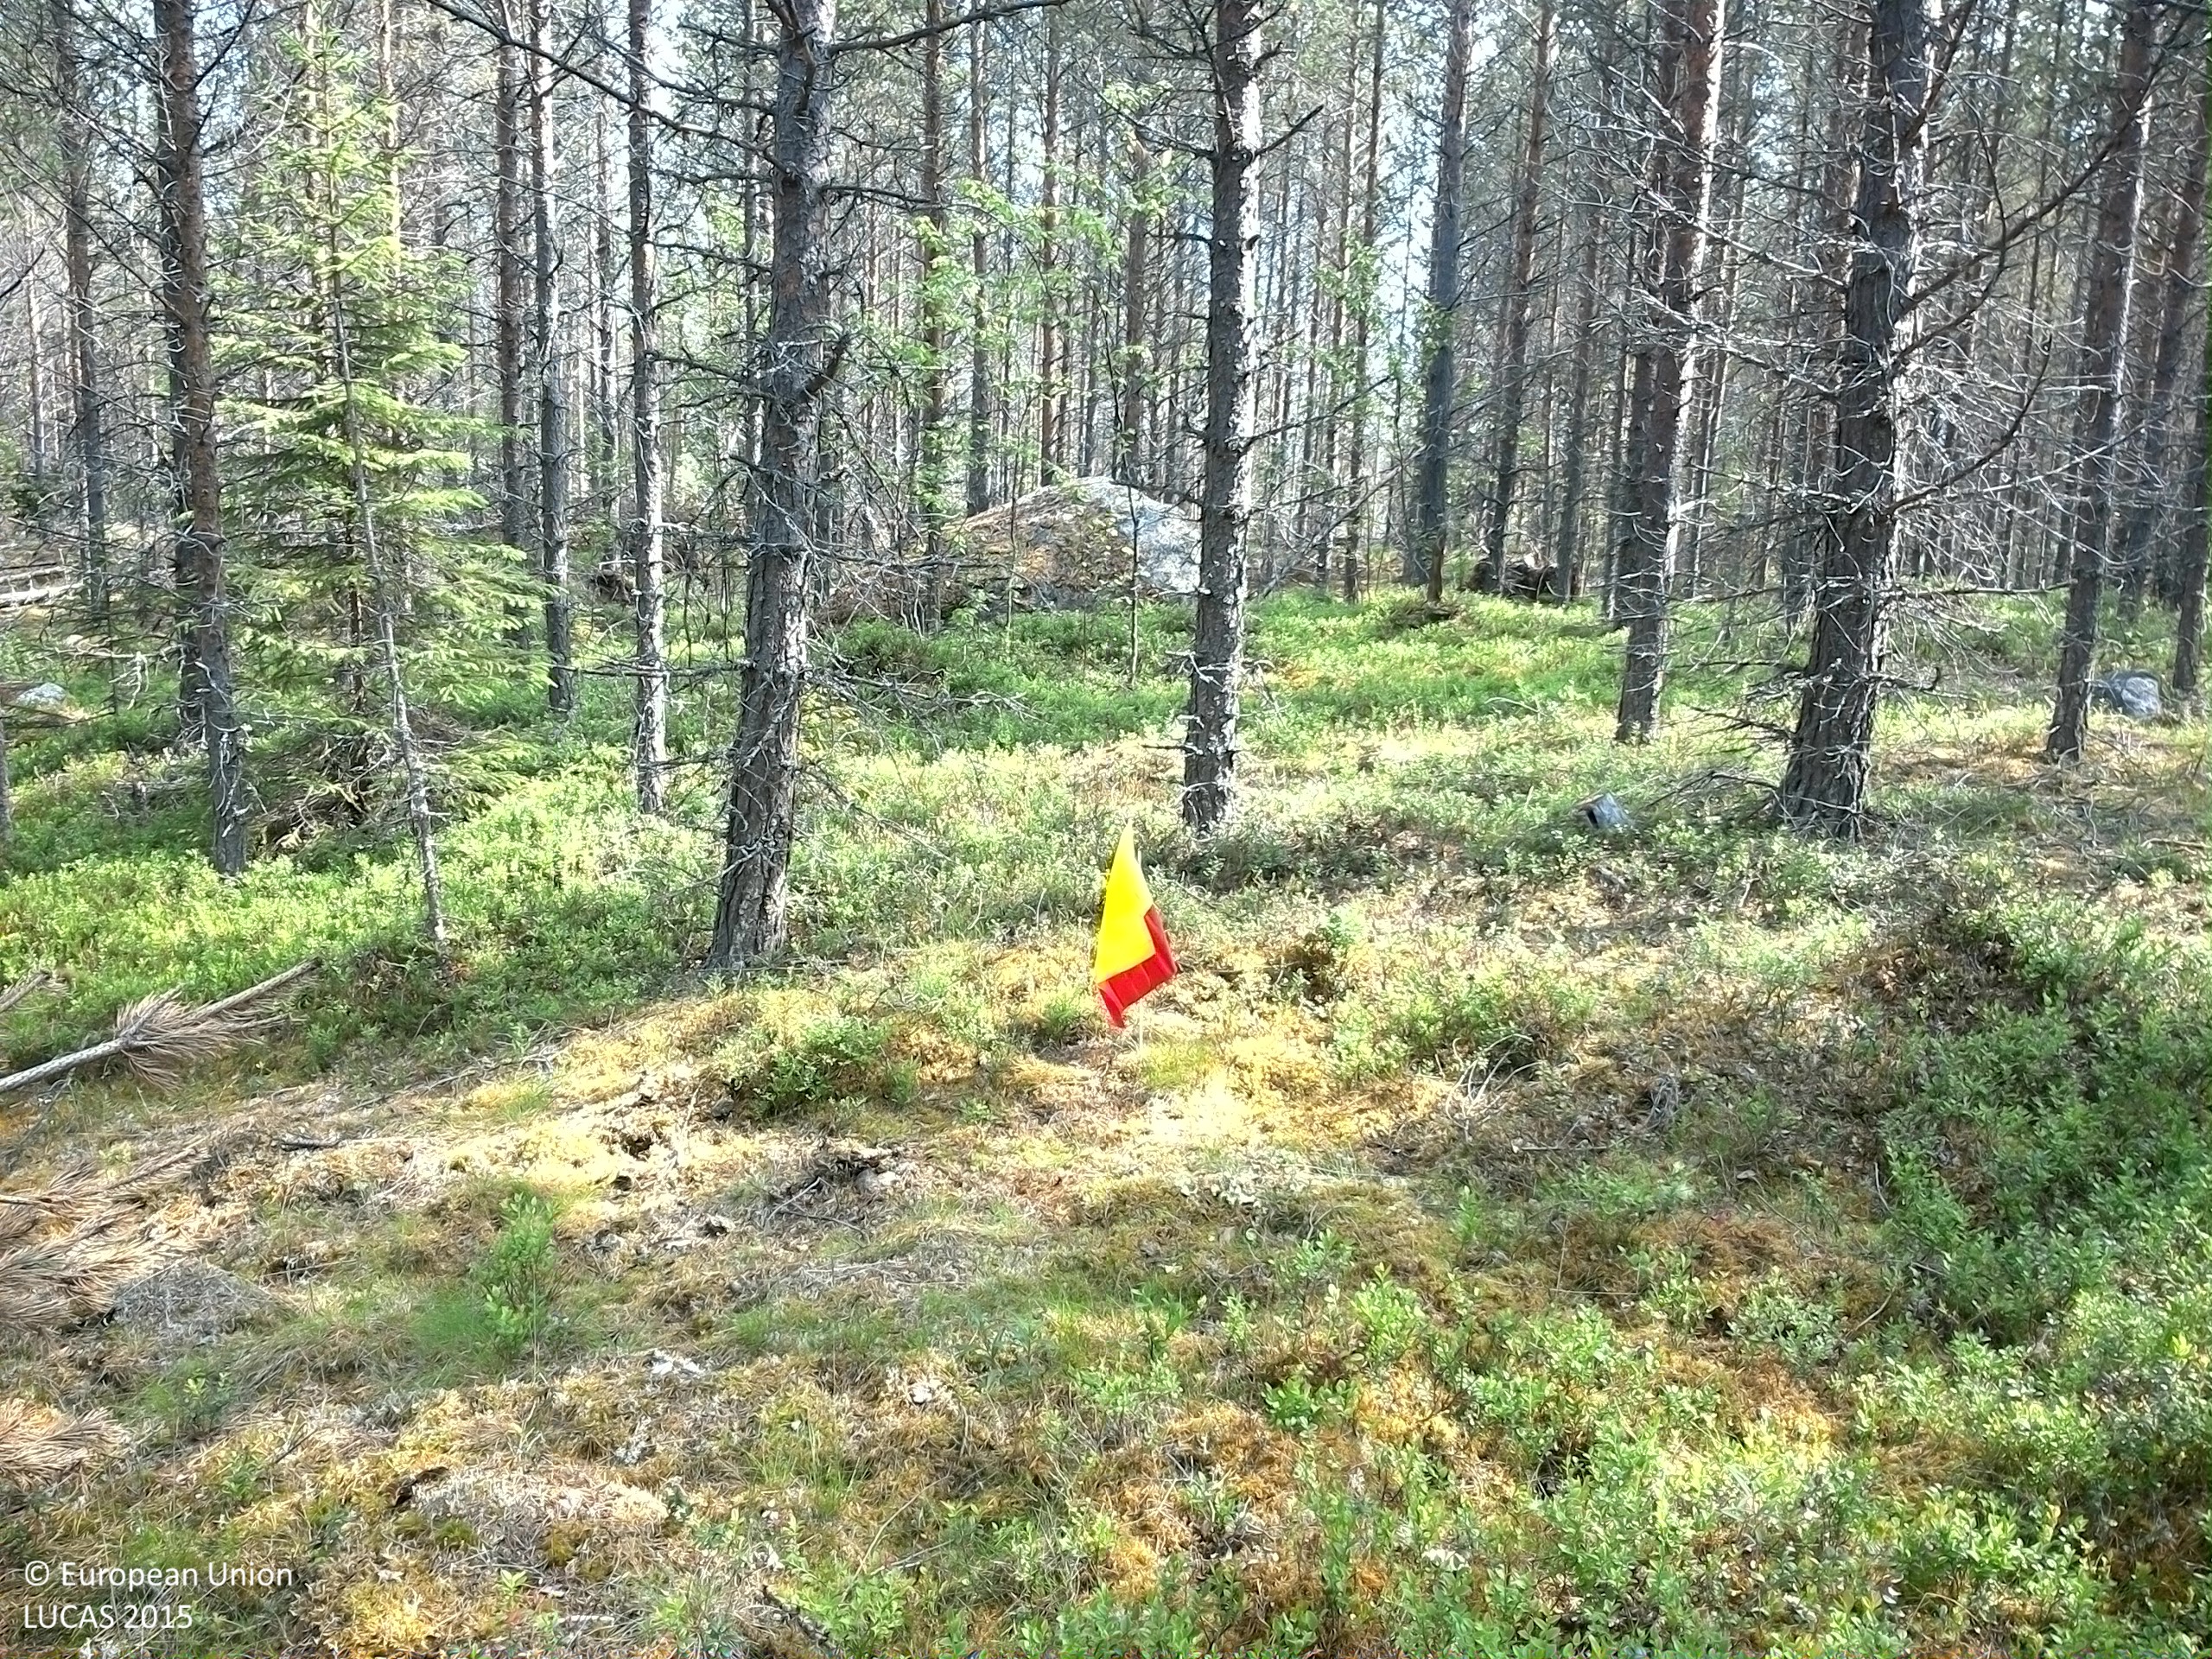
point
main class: Woodland
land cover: Pine dominated coniferous woodland
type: boreal forest
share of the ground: 25 - 50 %
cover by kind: coniferous forest trees 40 %, shrubs 35 %, lichens and mosses 10 %, broadleaved forest trees 5 %, herbaceous plants 5 %, consolidated bare surface 5 %
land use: Forestry
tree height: > 5 m
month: July
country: SE
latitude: 64.2380
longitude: 16.7124
